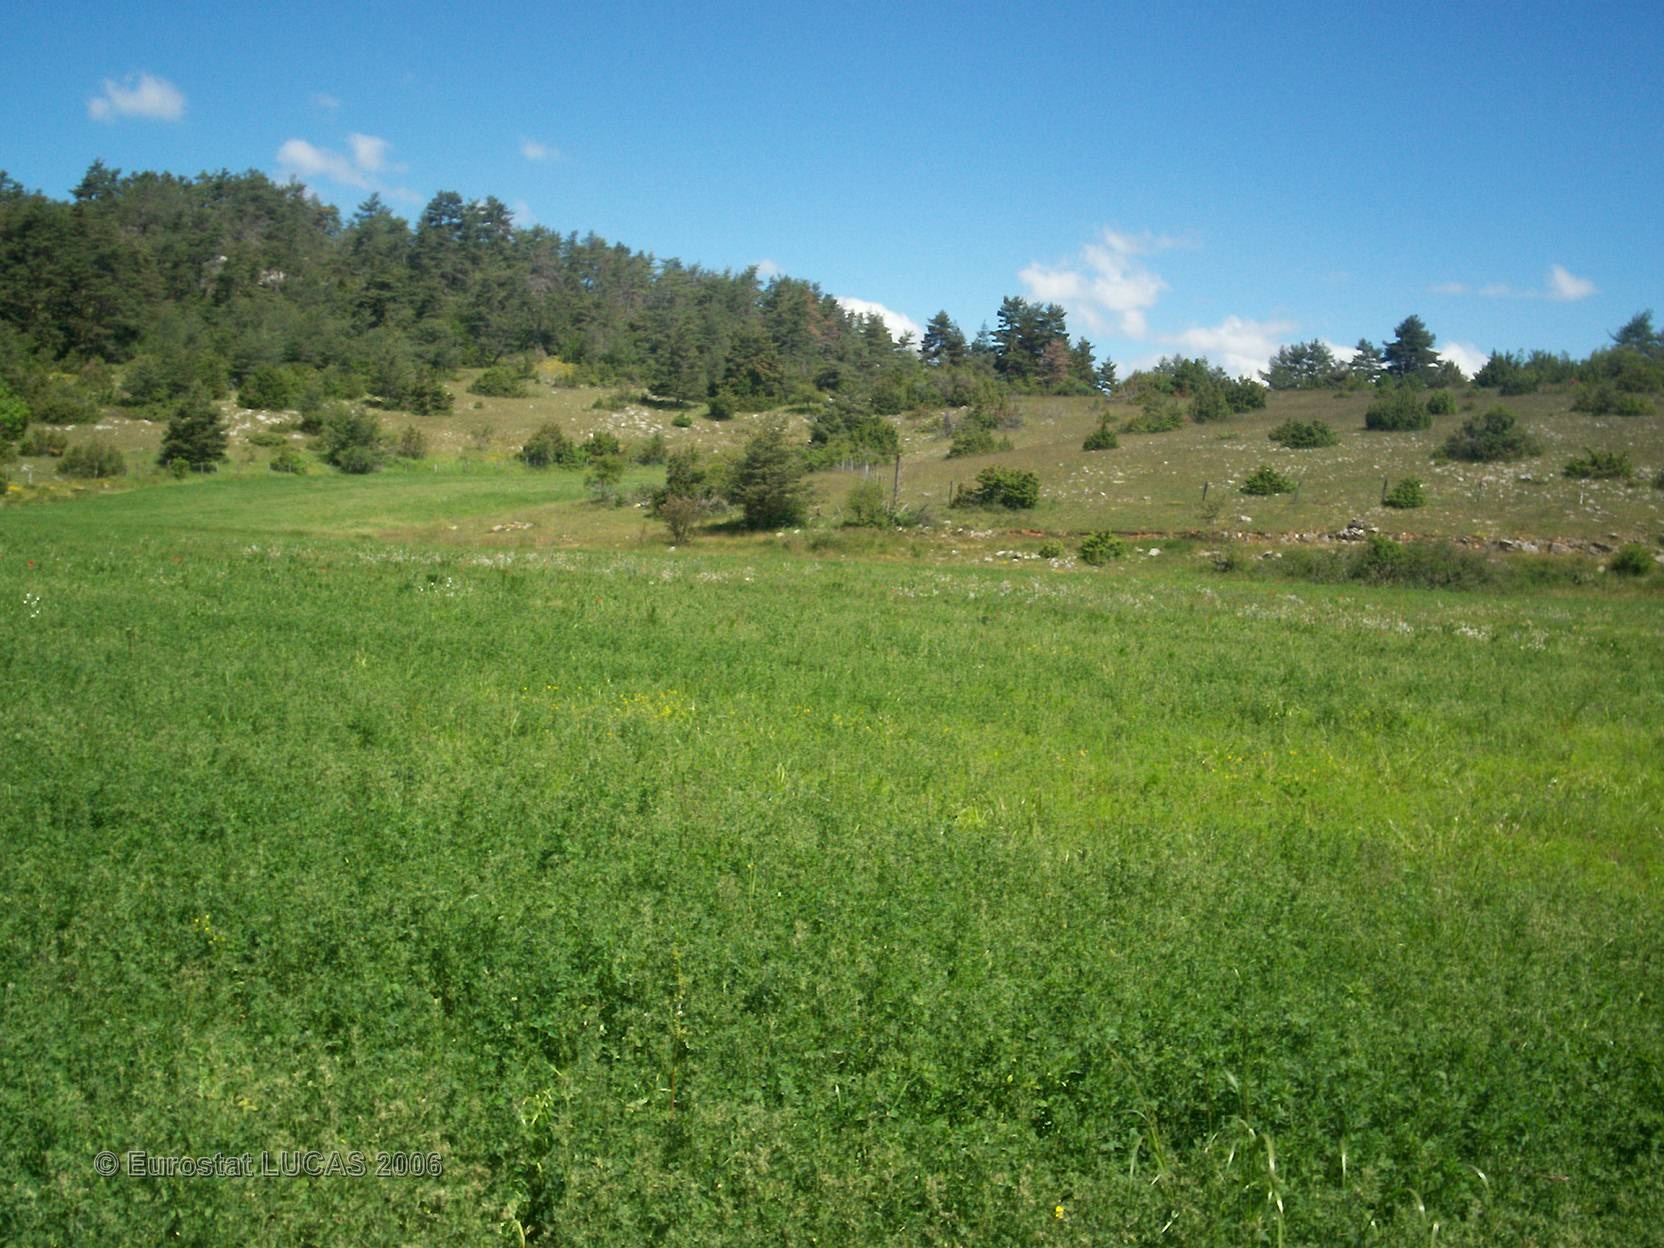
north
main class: Cropland
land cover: Other leguminous and mixtures for fodder
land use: Agriculture (excluding fallow land and kitchen gardens)
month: June
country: FR
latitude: 44.4077
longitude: 3.3374
